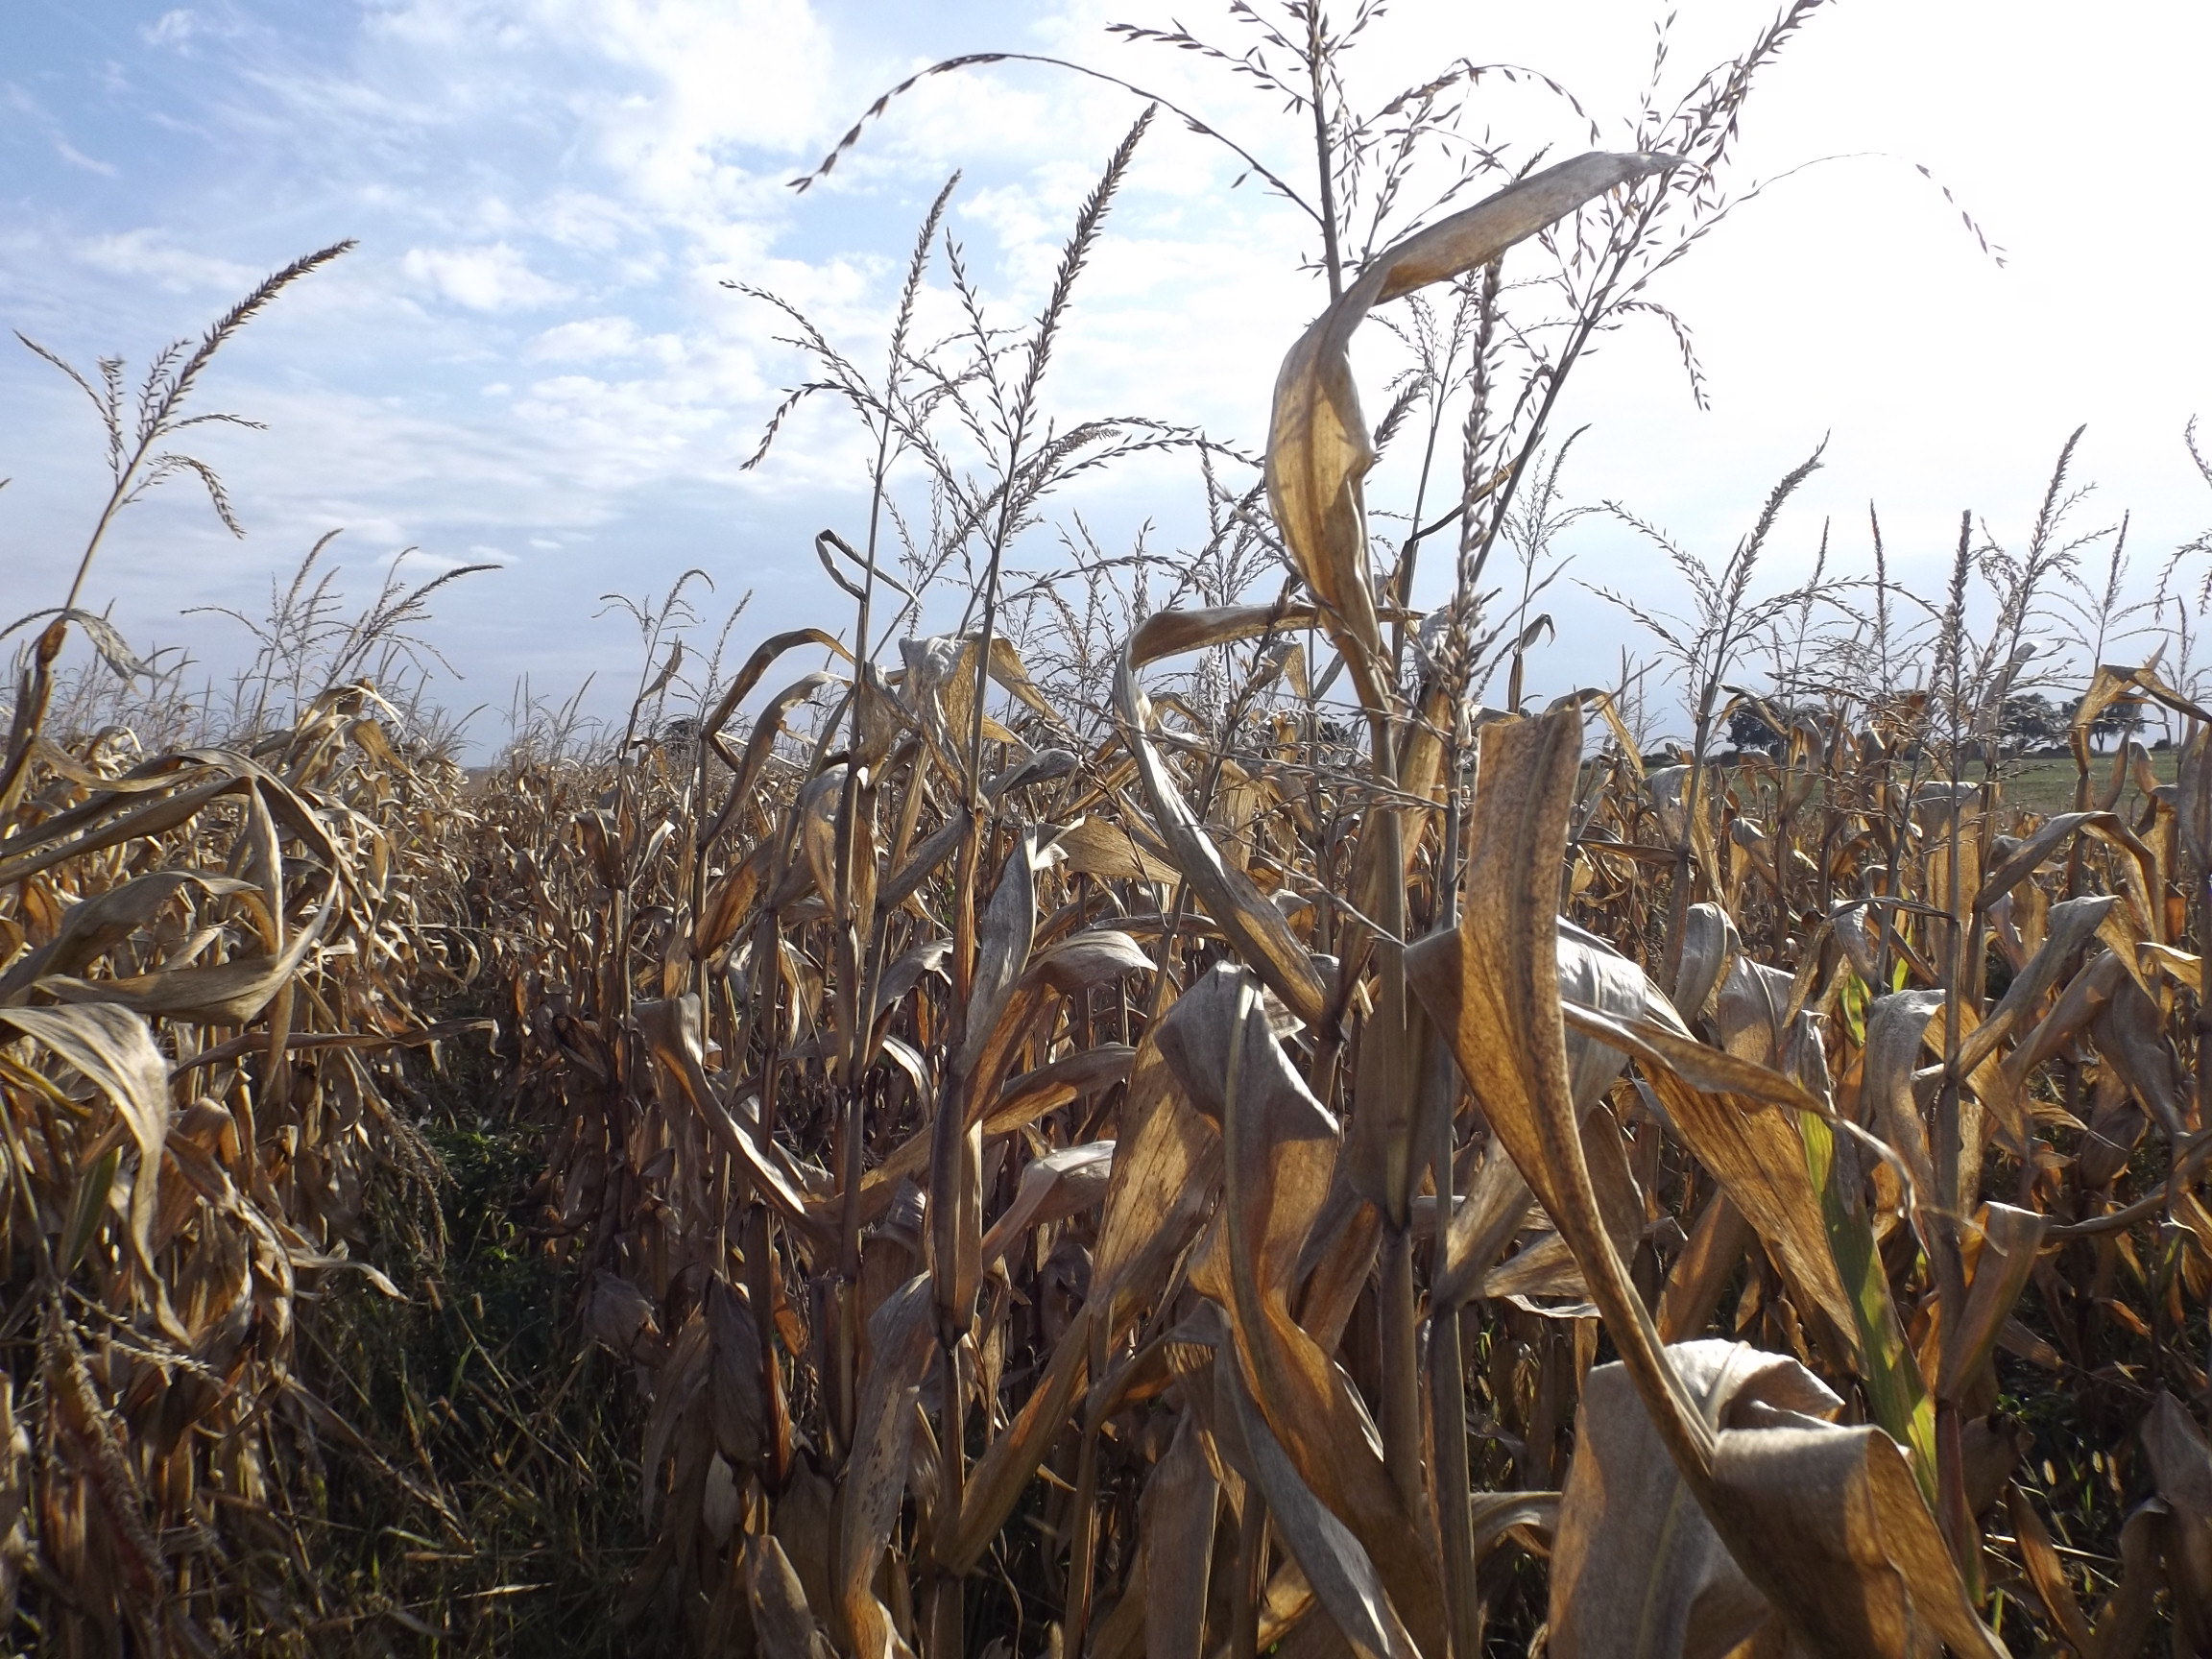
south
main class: Cropland
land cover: Maize
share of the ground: > 75 %
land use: Agriculture (excluding fallow land and kitchen gardens)
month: October
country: BG
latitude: 43.9302
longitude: 26.7705
